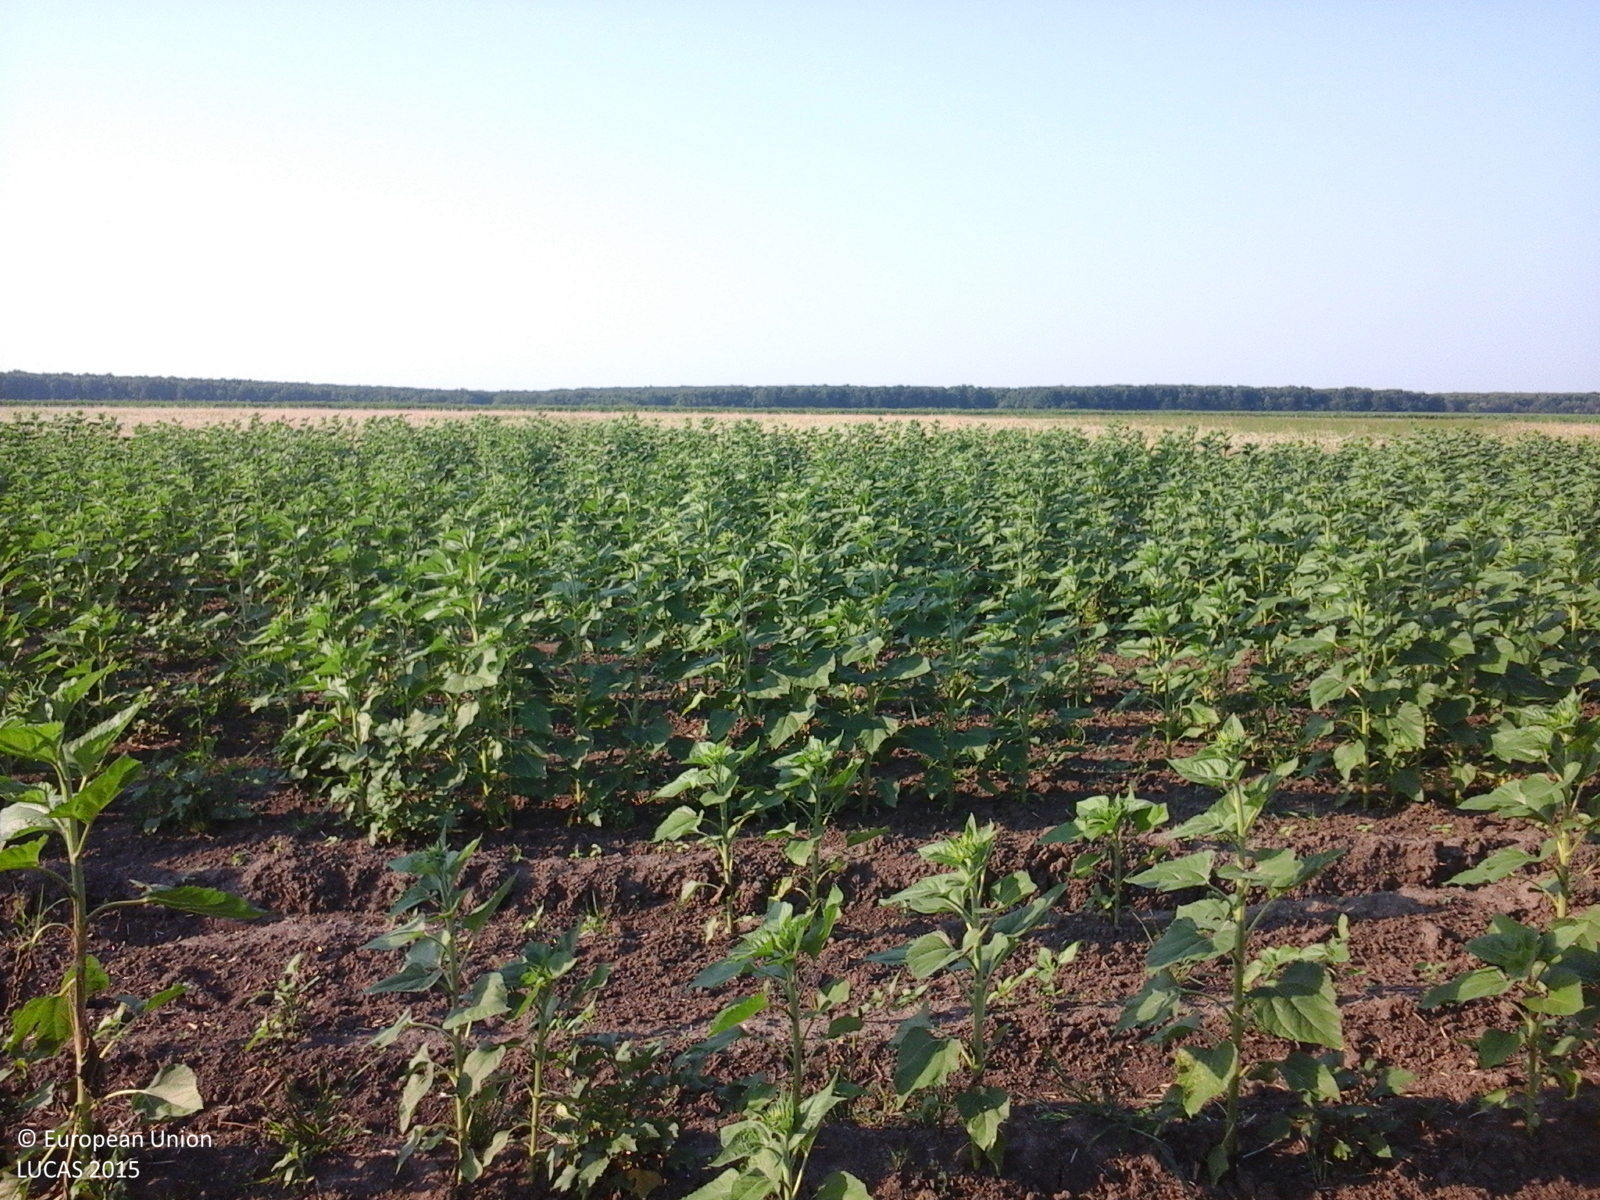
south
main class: Cropland
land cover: Sunflower
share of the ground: 50 - 75 %
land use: Agriculture (excluding fallow land and kitchen gardens)
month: July
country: RO
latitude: 44.5718
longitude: 24.7467
